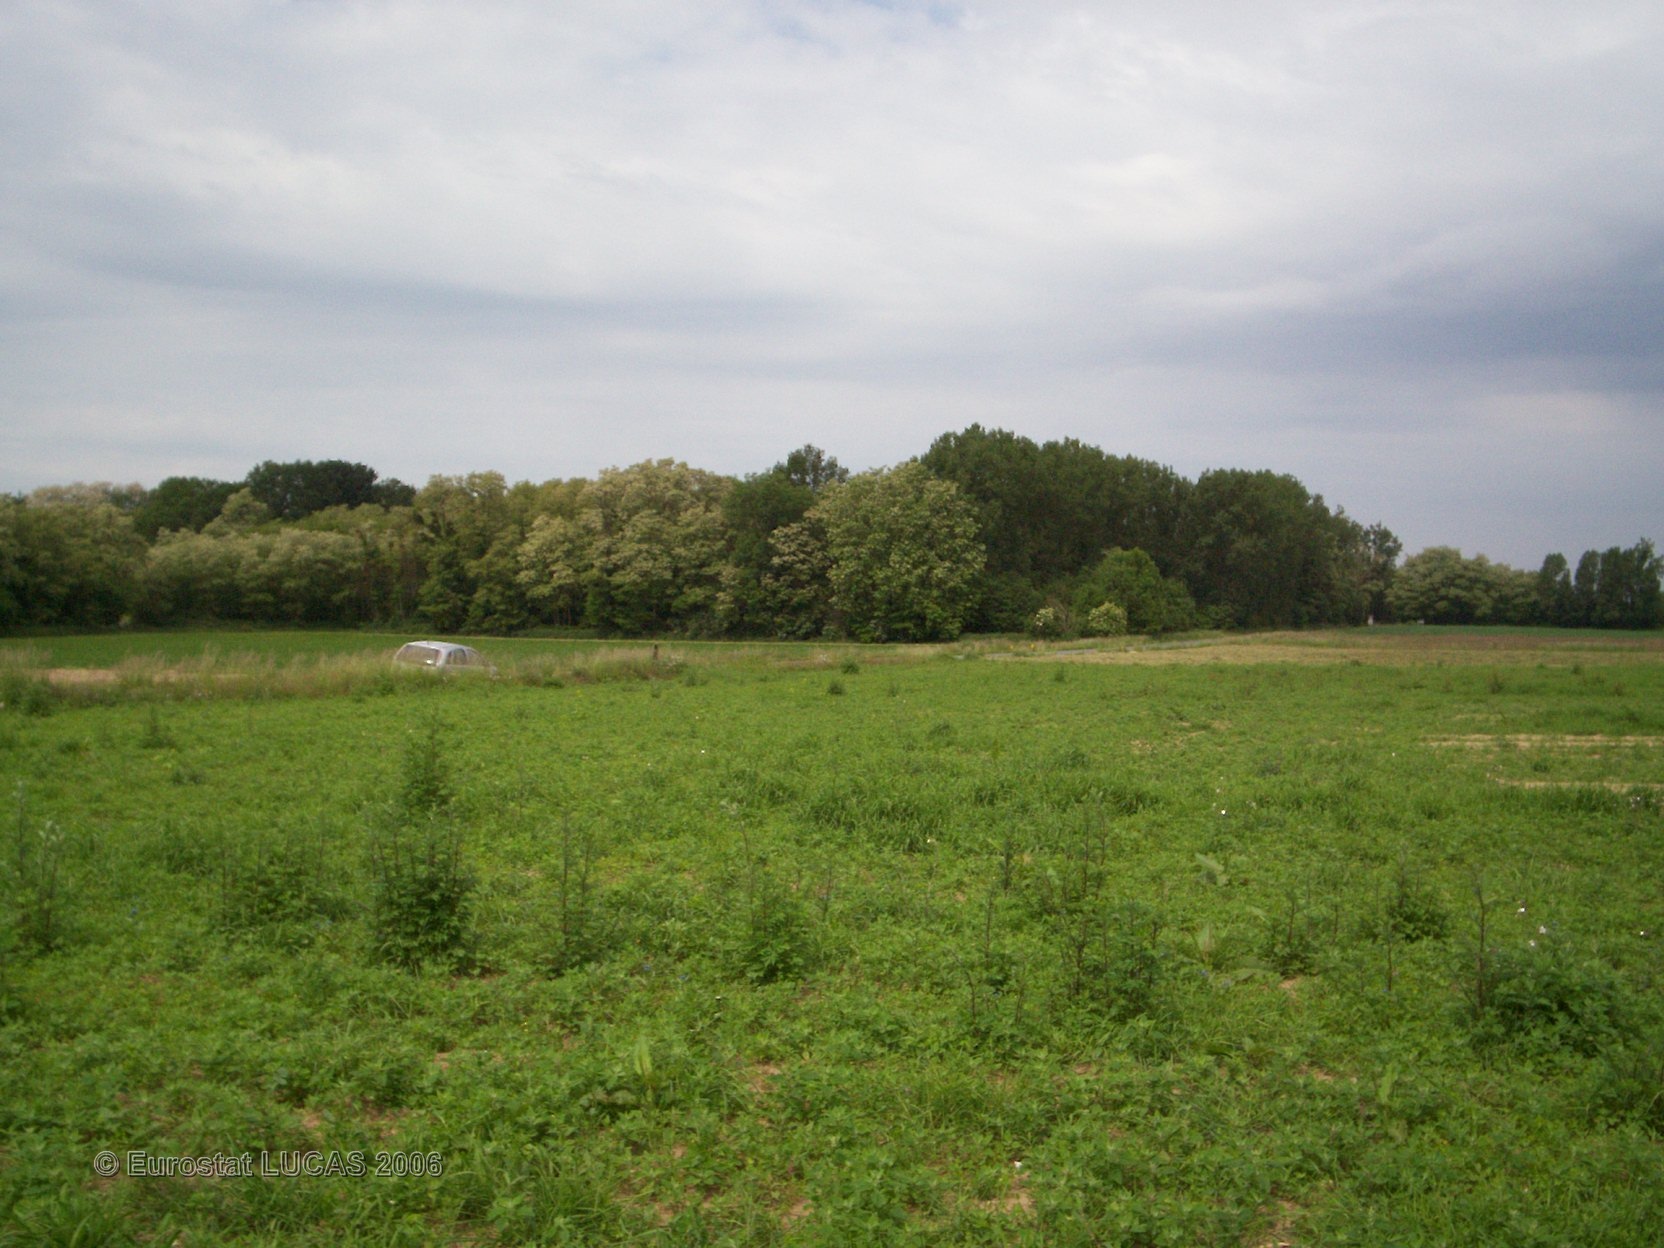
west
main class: Grassland
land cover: Grassland without tree/shrub cover
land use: Agriculture (excluding fallow land and kitchen gardens)
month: June
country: FR
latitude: 49.4279
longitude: 2.7232
